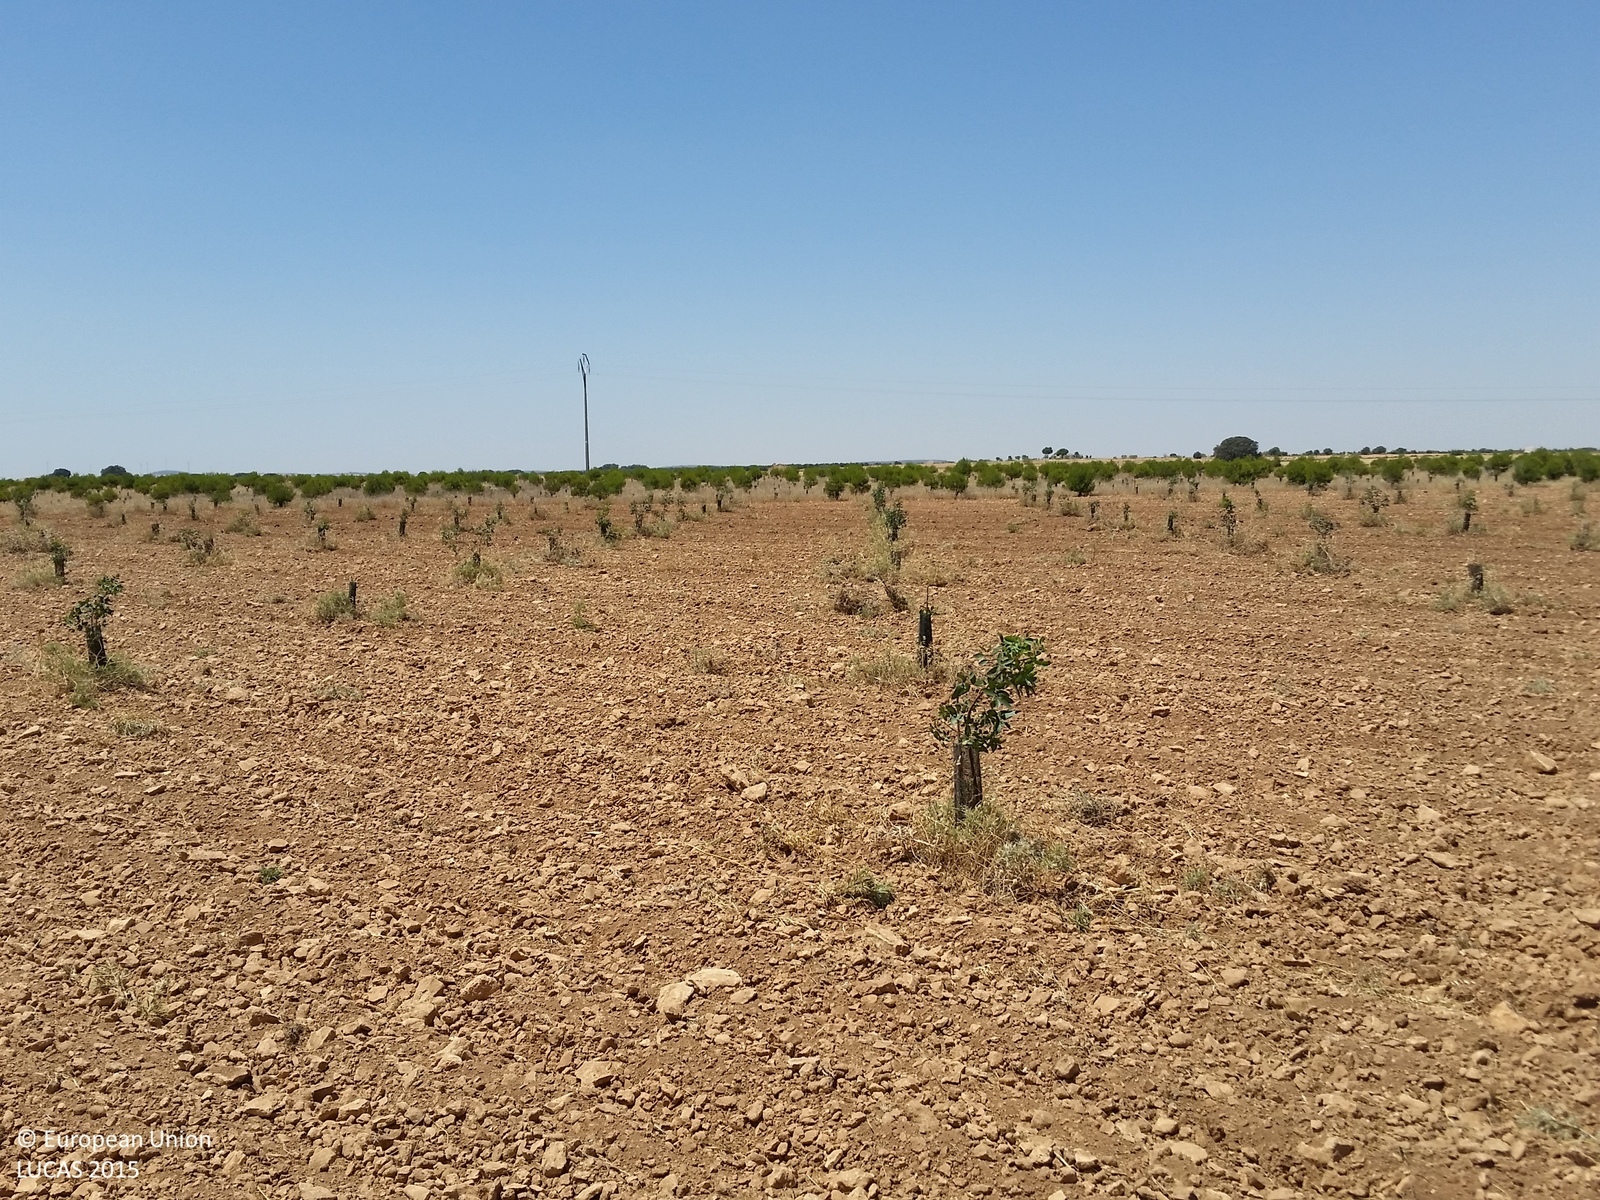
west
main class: Cropland
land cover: Nuts trees
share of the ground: < 10 %
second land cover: Other bare soil
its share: > 75 %
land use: Agriculture (excluding fallow land and kitchen gardens)
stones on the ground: 10 - 25 %
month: July
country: ES
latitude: 39.1276
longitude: -2.5586
